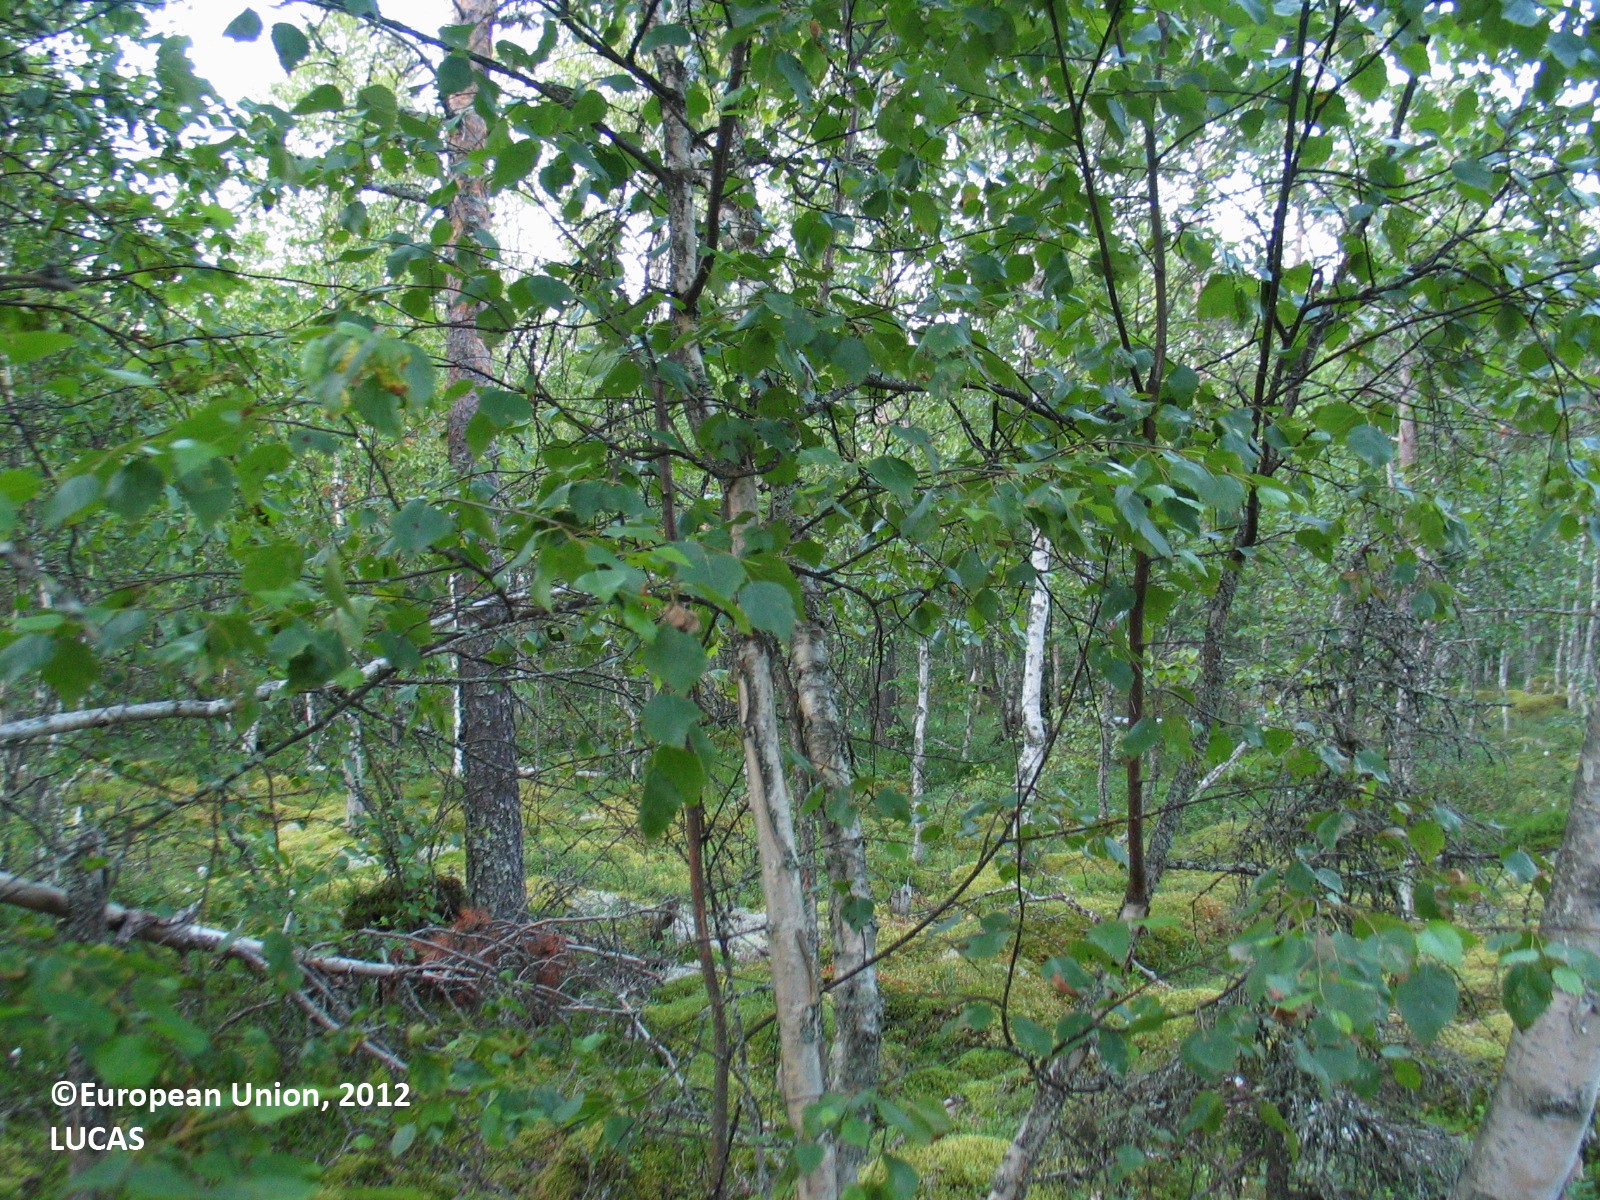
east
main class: Woodland
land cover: Other mixed woodland
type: mire and swamp forests
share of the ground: 50 - 75 %
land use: Semi-natural and natural areas not in use
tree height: > 5 m
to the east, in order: Other mixed woodland; Ditches and canals; Other mixed woodland; Ditches and canals; Other mixed woodland; Ditches and canals; Other mixed woodland; Ditches and canals; Other mixed woodland
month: July
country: FI
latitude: 64.6125
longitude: 26.5667
